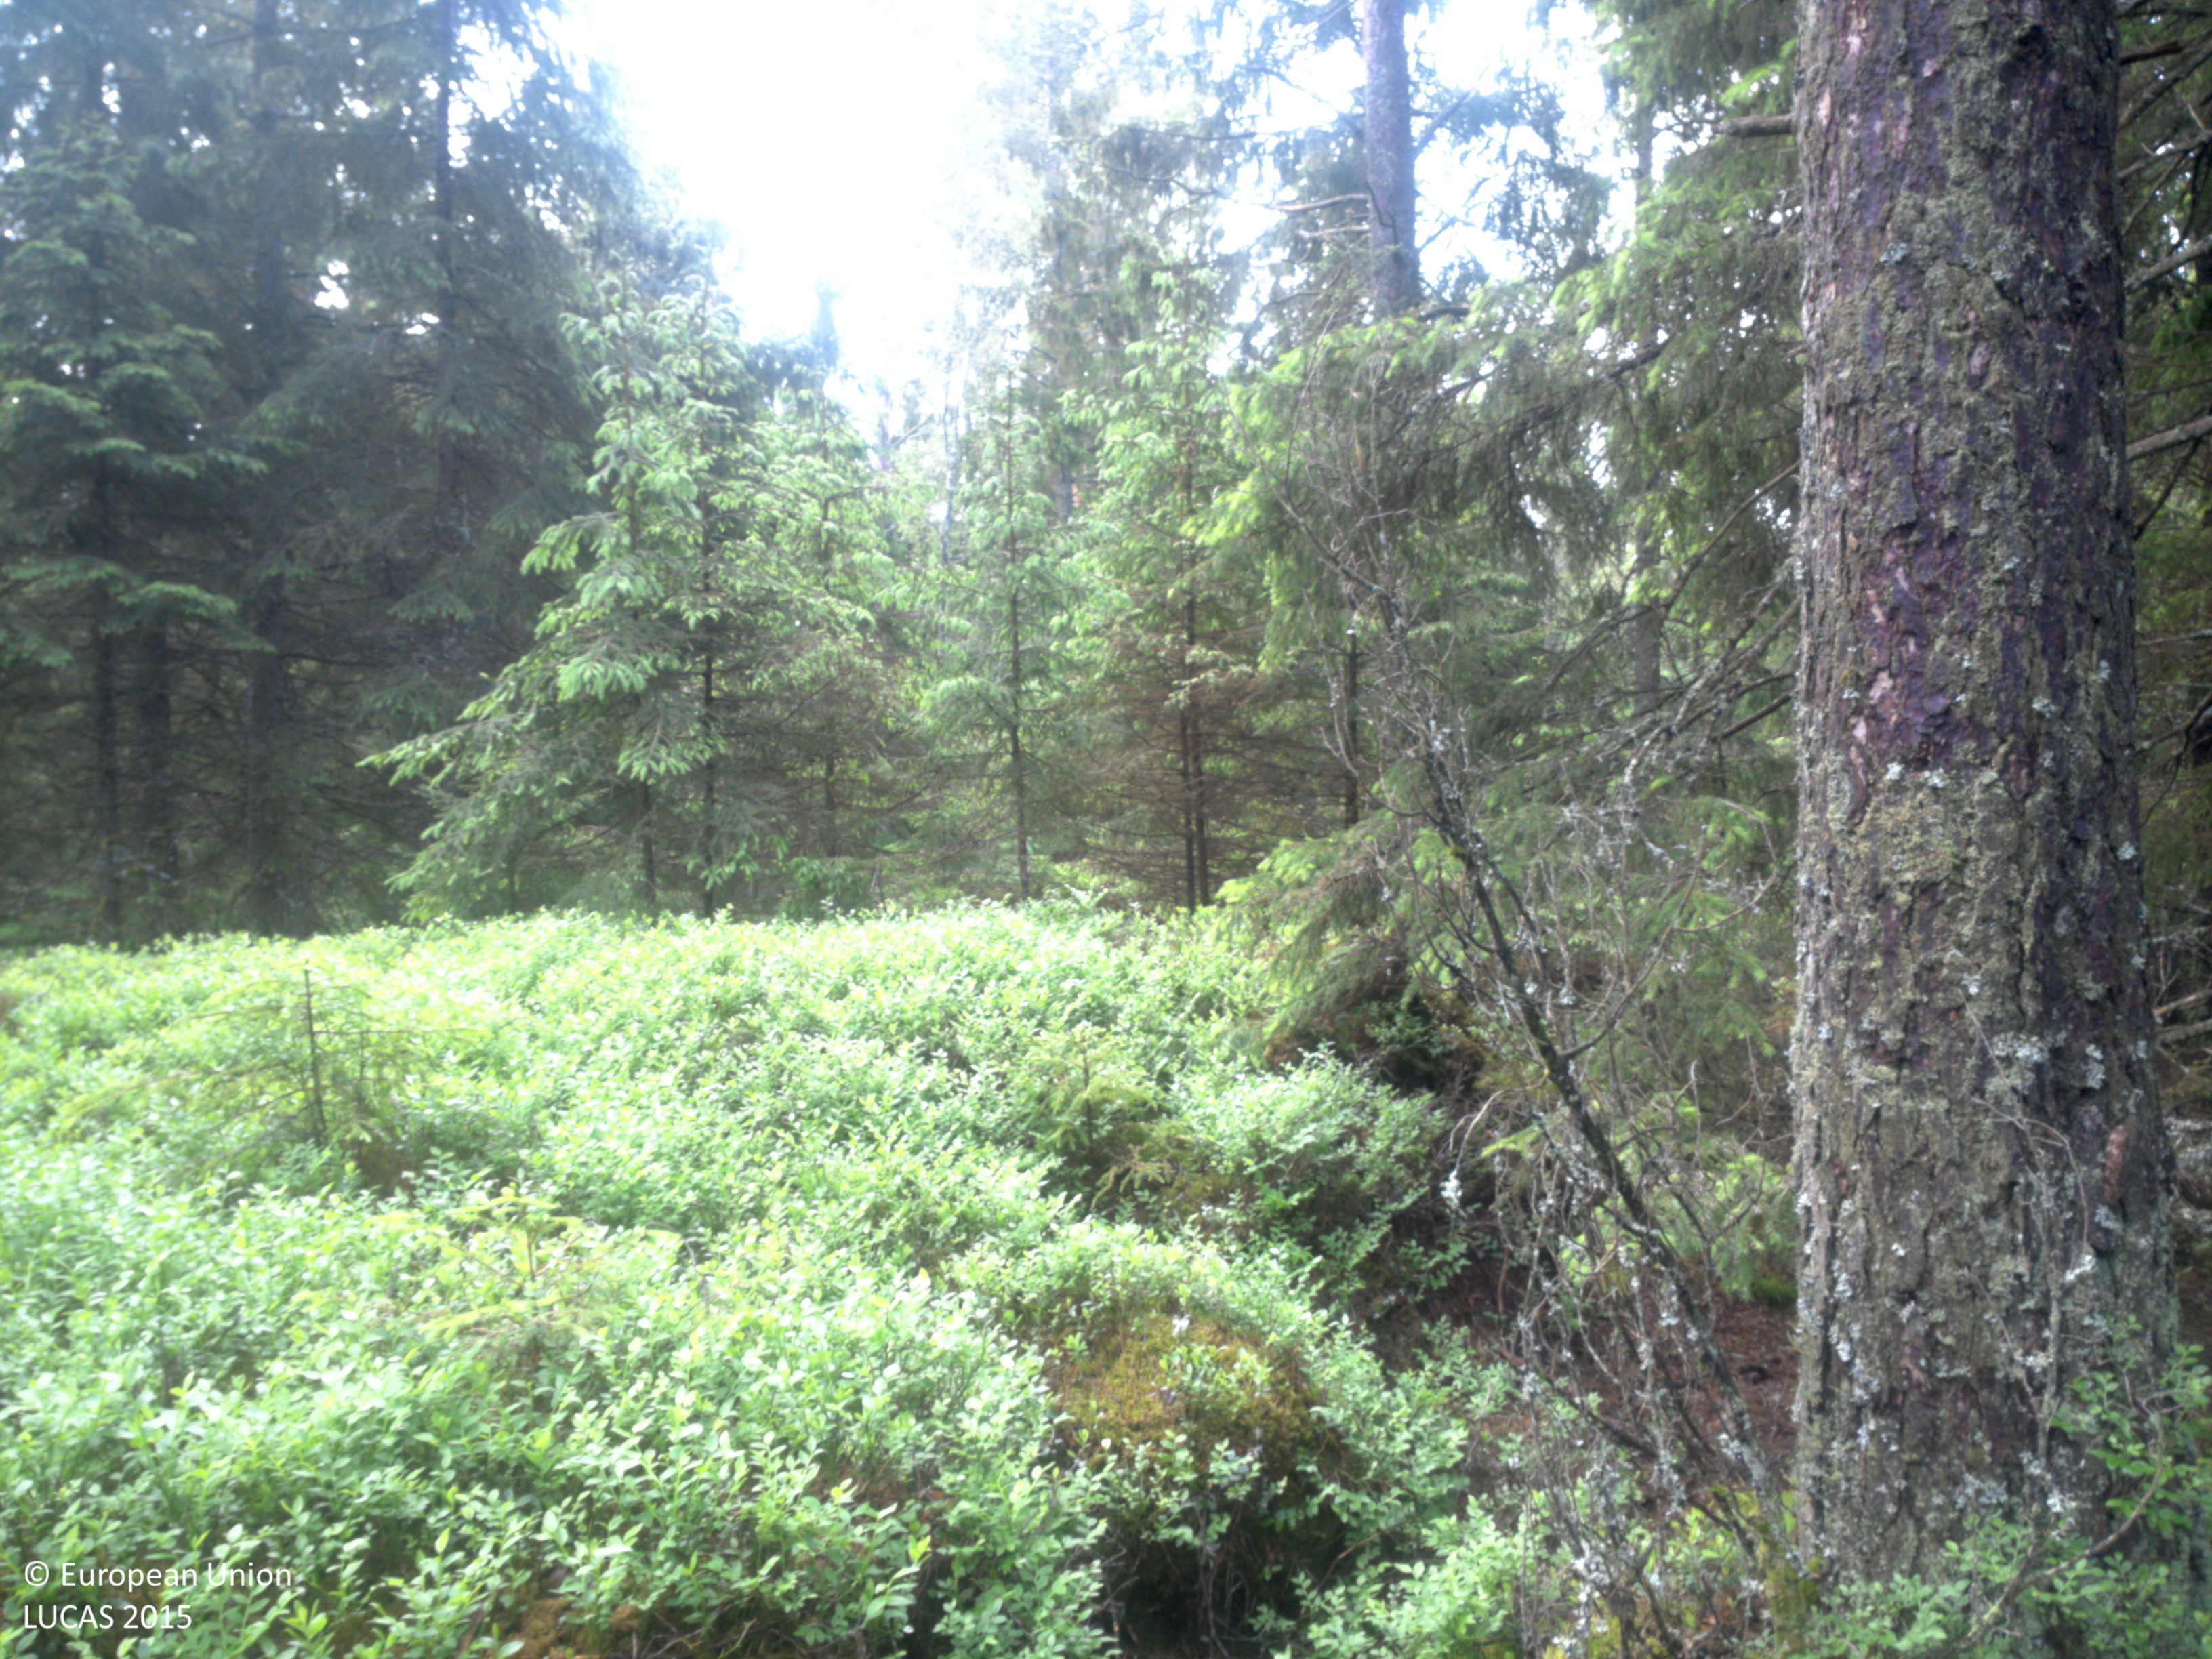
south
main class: Woodland
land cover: Spruce dominated coniferous woodland
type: boreal forest
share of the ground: 50 - 75 %
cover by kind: coniferous forest trees 50 %, lichens and mosses 30 %, shrubs 20 %
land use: Forestry
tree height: > 5 m
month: June
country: SE
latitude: 58.4054
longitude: 11.7932
